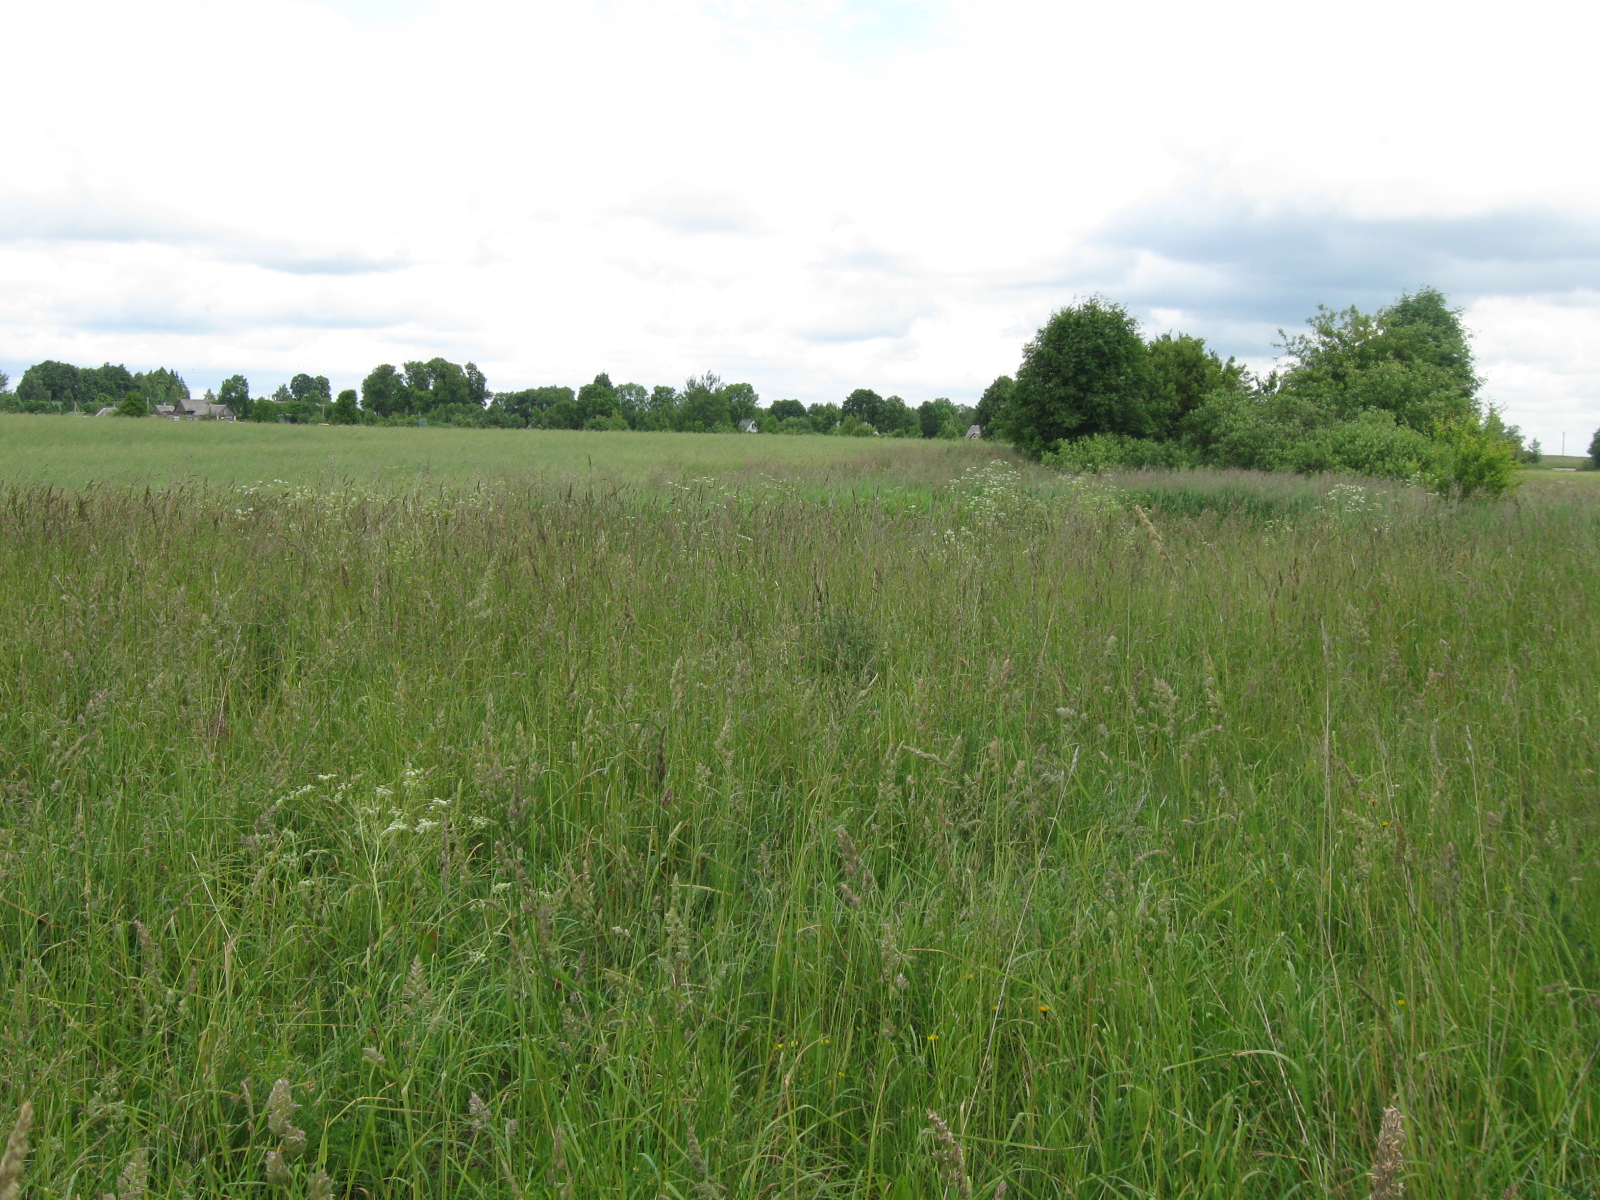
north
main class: Grassland
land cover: Grassland without tree/shrub cover
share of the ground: > 75 %
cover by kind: herbaceous plants 100 %
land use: Agriculture (excluding fallow land and kitchen gardens)
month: June
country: LT
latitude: 54.9288
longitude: 24.5697
